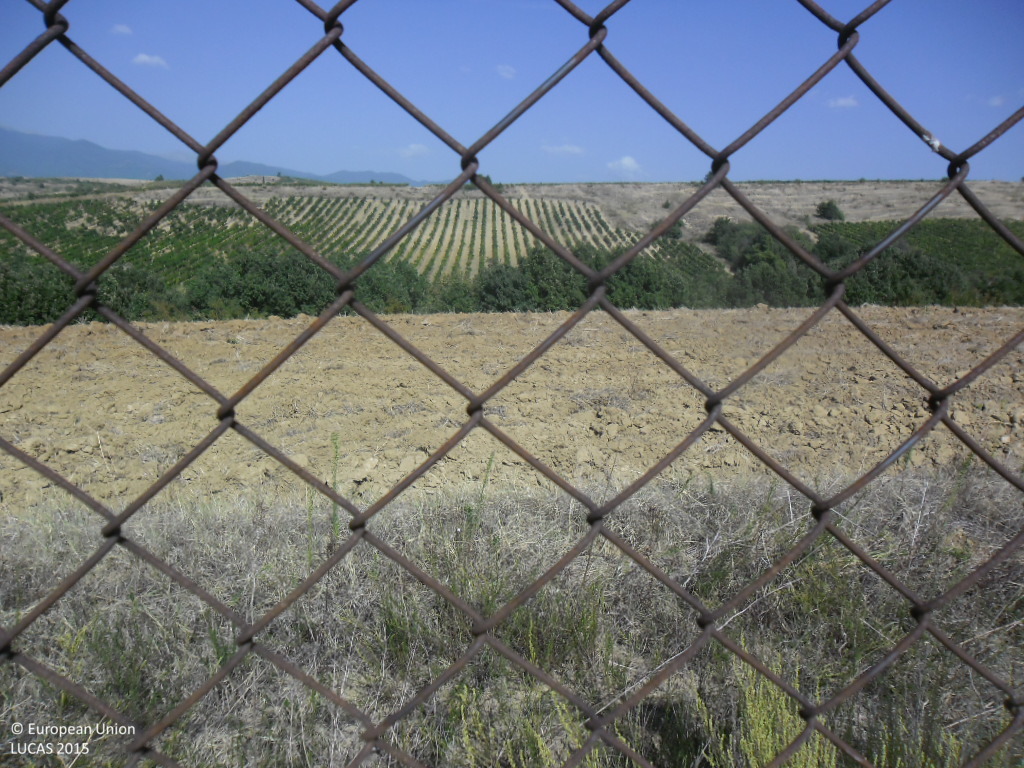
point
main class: Grassland
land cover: Spontaneously vegetated surfaces
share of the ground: 25 - 50 %
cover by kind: herbaceous plants 90 %, unconsolidated bare surface 10 %
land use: Agriculture (excluding fallow land and kitchen gardens)
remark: Harvested field
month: September
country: BG
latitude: 41.4911
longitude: 23.3534
